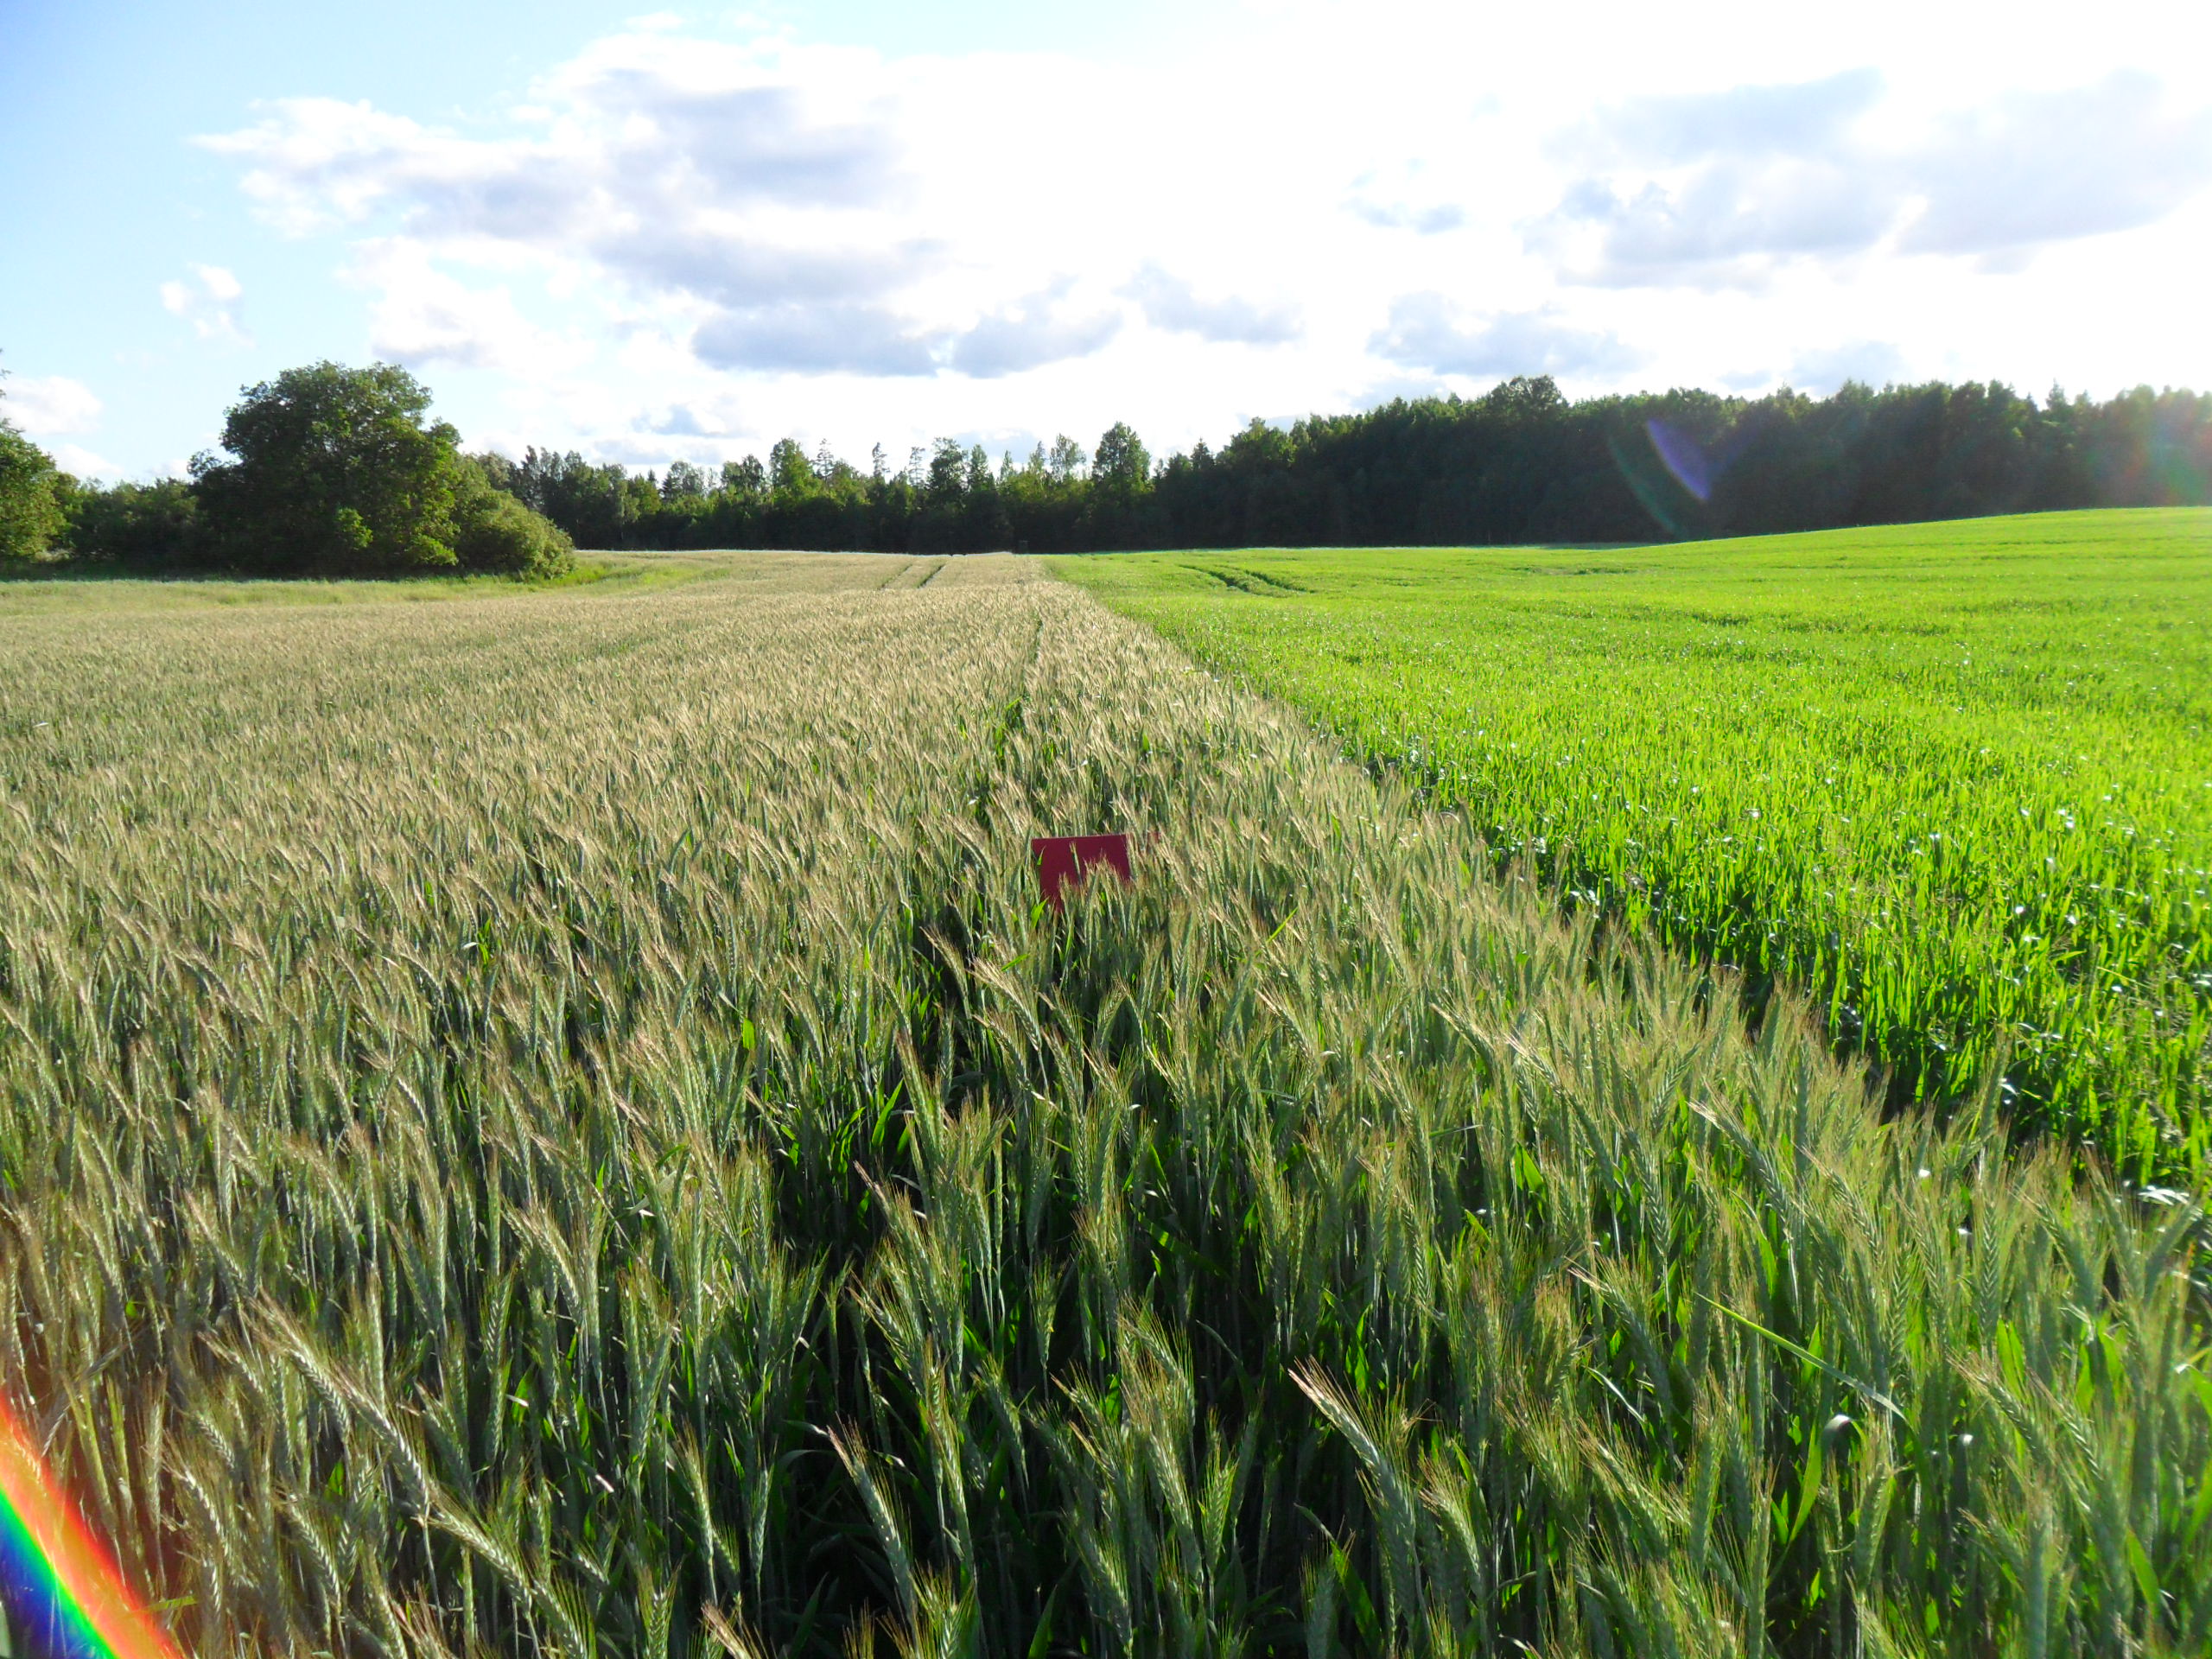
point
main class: Cropland
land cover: Rye
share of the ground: > 75 %
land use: Agriculture (excluding fallow land and kitchen gardens)
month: June
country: LV
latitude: 57.1493
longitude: 22.9715
